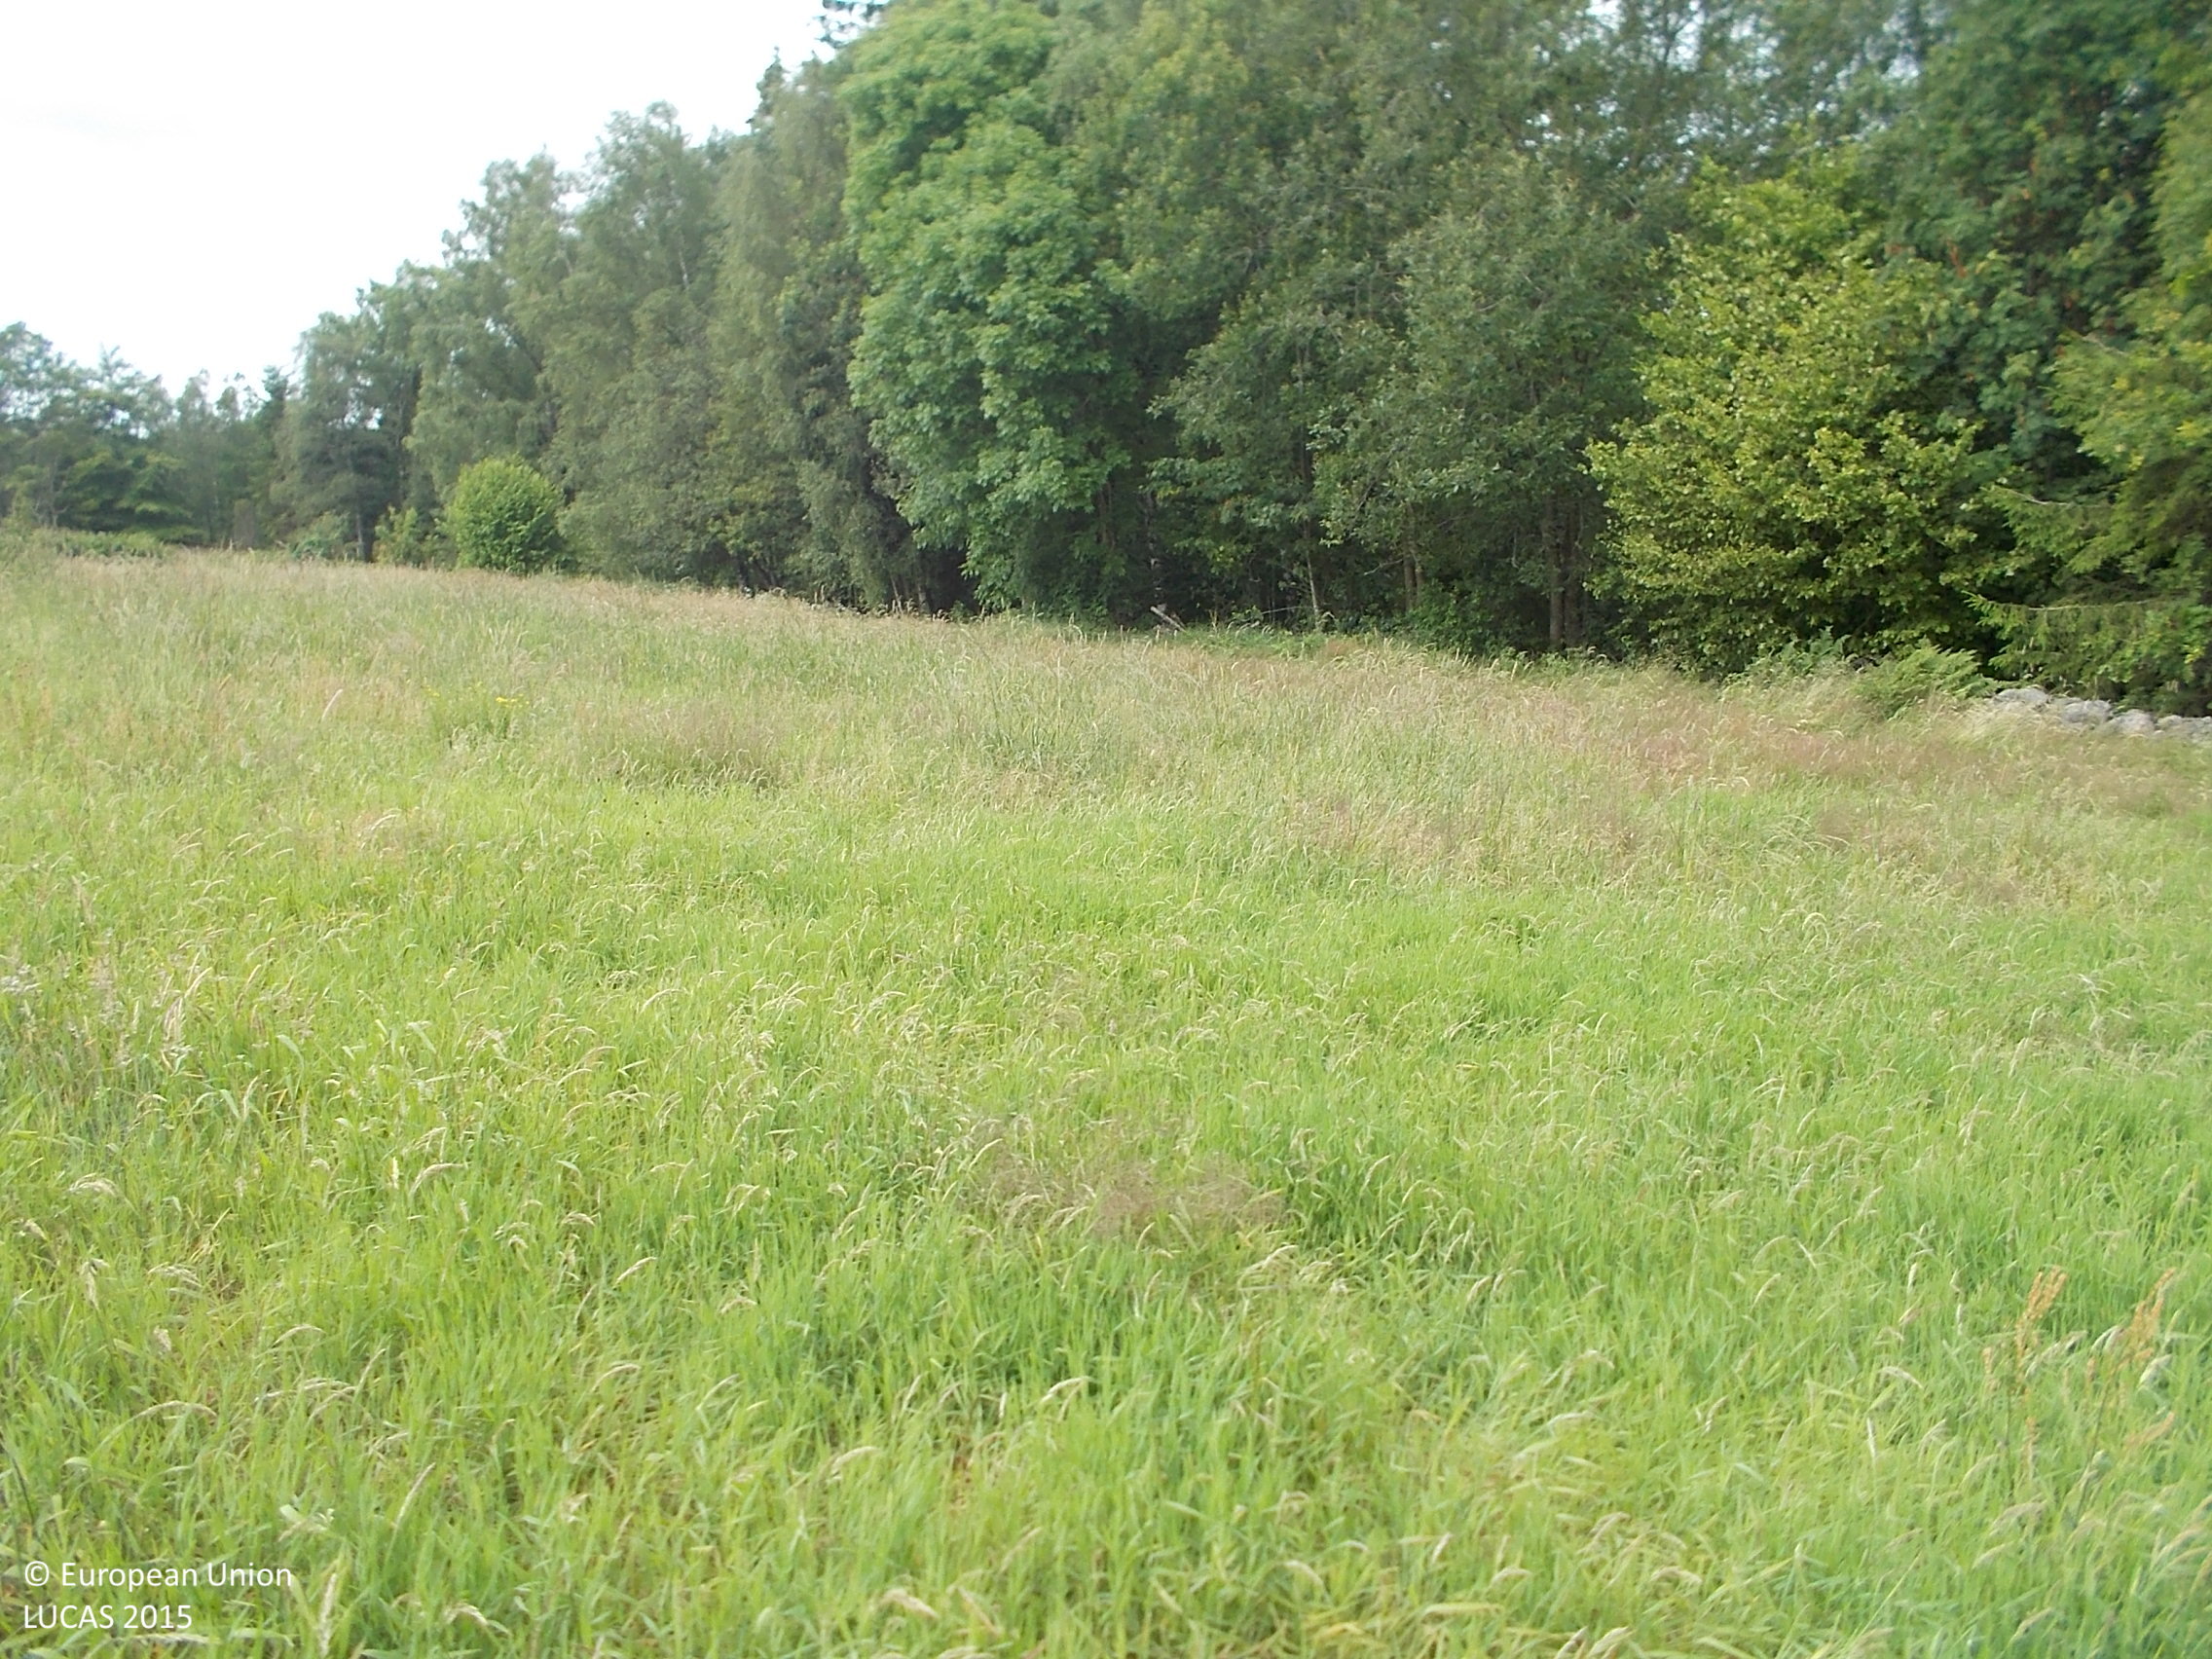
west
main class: Grassland
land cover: Grassland without tree/shrub cover
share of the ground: > 75 %
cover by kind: herbaceous plants 100 %
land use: Agriculture (excluding fallow land and kitchen gardens)
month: July
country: SE
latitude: 57.4266
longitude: 12.2781
